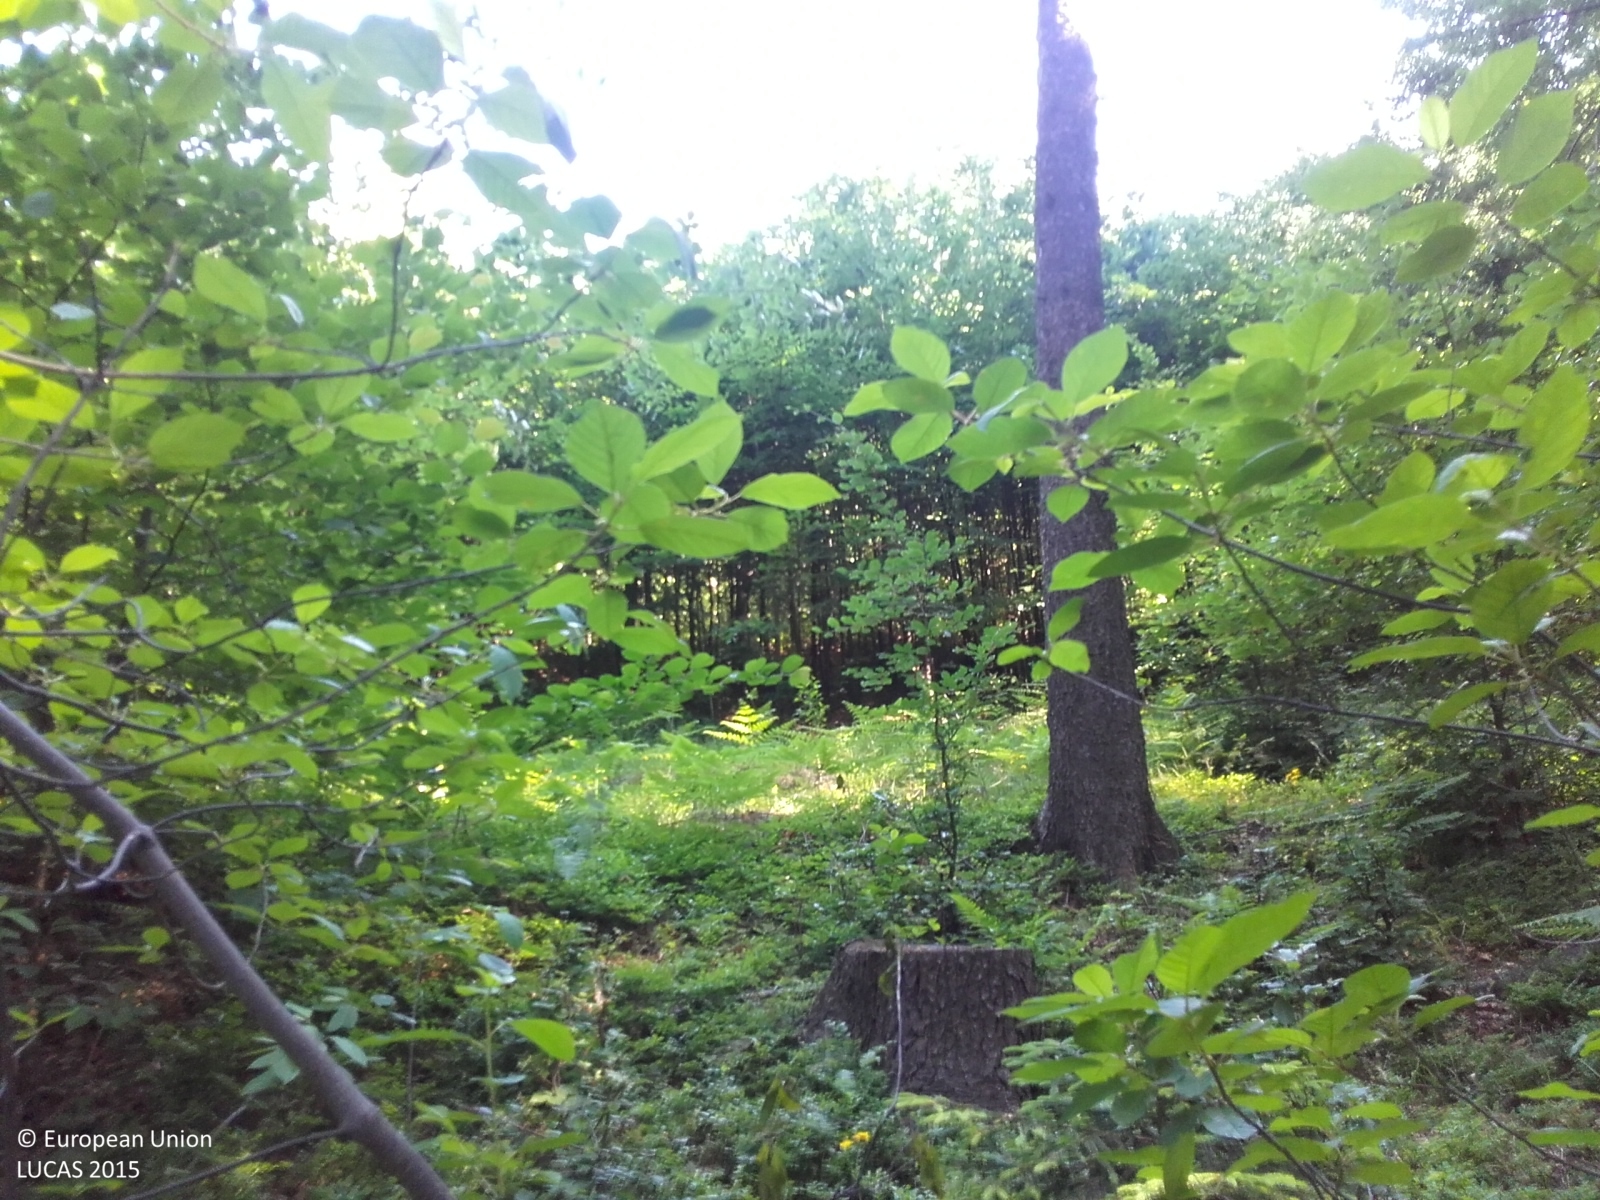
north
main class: Woodland
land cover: Spruce dominated mixed woodland
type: hemiboreal forest and nemoral coniferous forest and mixed broadleaved-coniferous forest
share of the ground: > 75 %
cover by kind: coniferous forest trees 60 %, broadleaved forest trees 30 %, herbaceous plants 10 %
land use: Forestry
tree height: > 5 m
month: June
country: CZ
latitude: 49.6119
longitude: 18.7533
